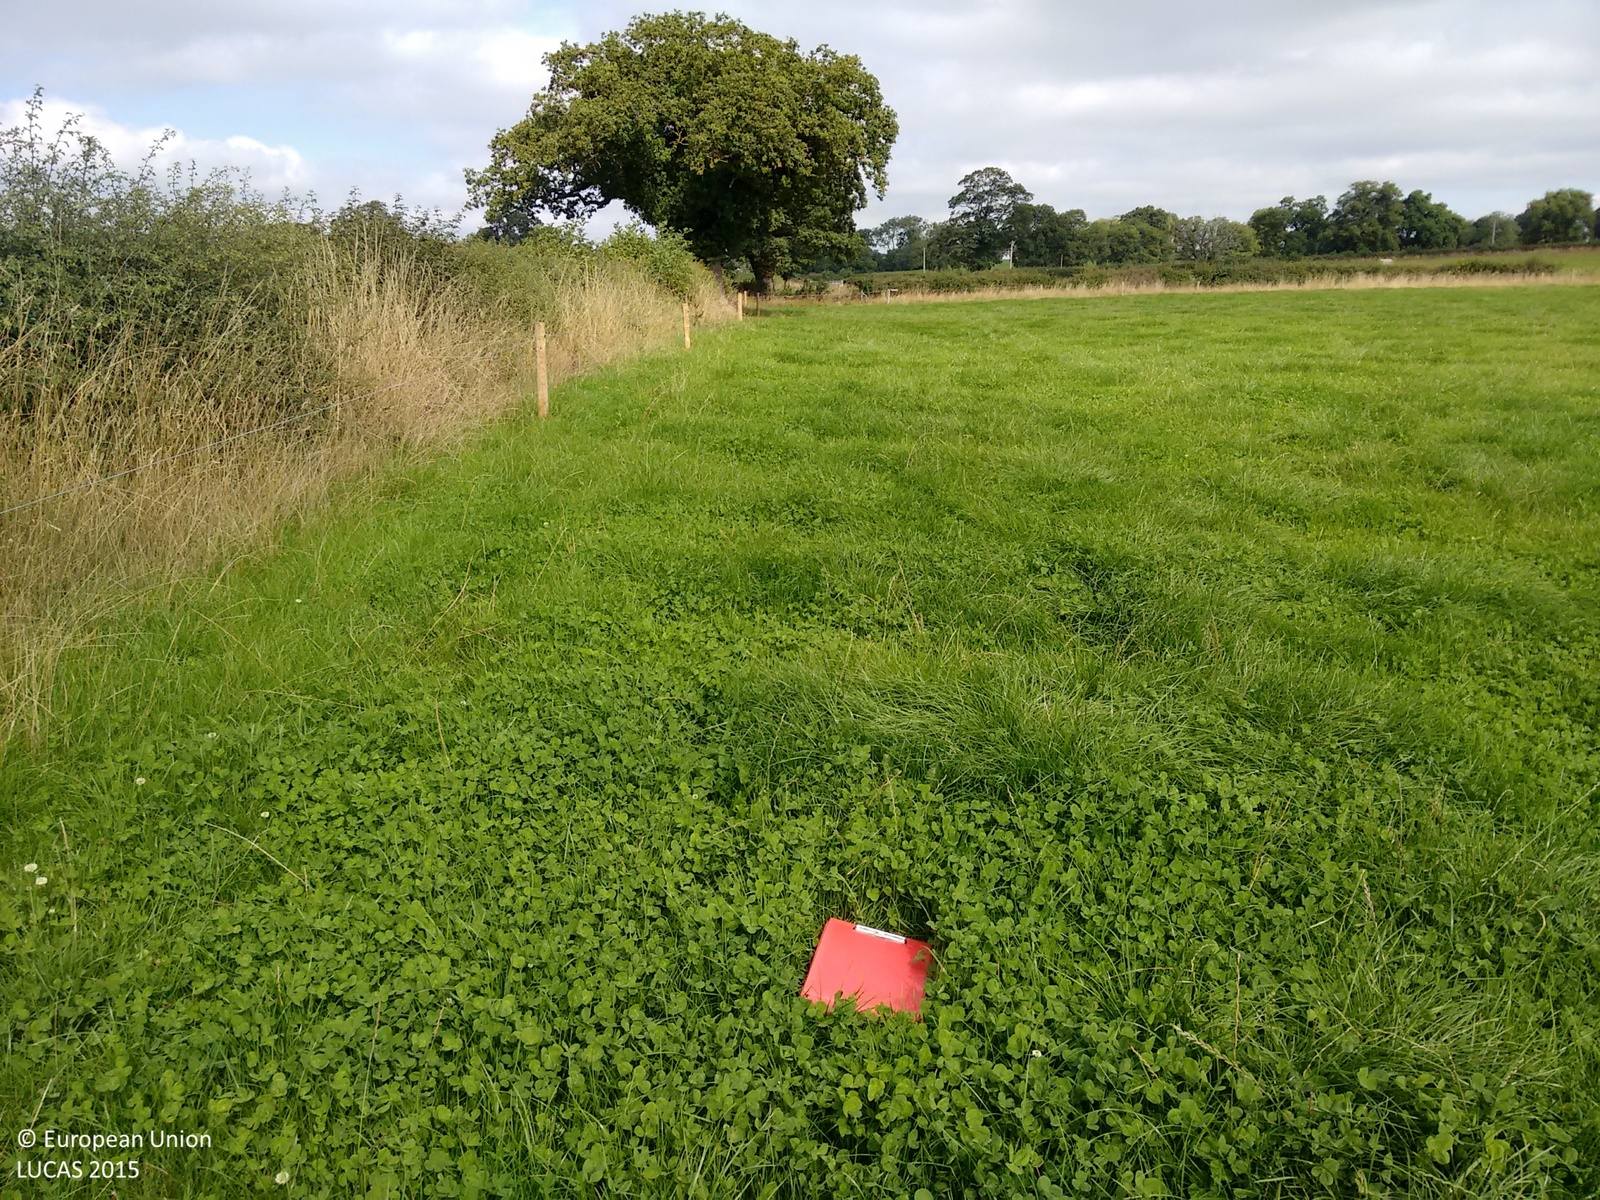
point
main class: Grassland
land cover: Grassland without tree/shrub cover
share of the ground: > 75 %
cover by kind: herbaceous plants 100 %
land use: Agriculture (excluding fallow land and kitchen gardens)
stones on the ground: < 10 %
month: September
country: GB
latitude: 52.9395
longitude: -2.6116
